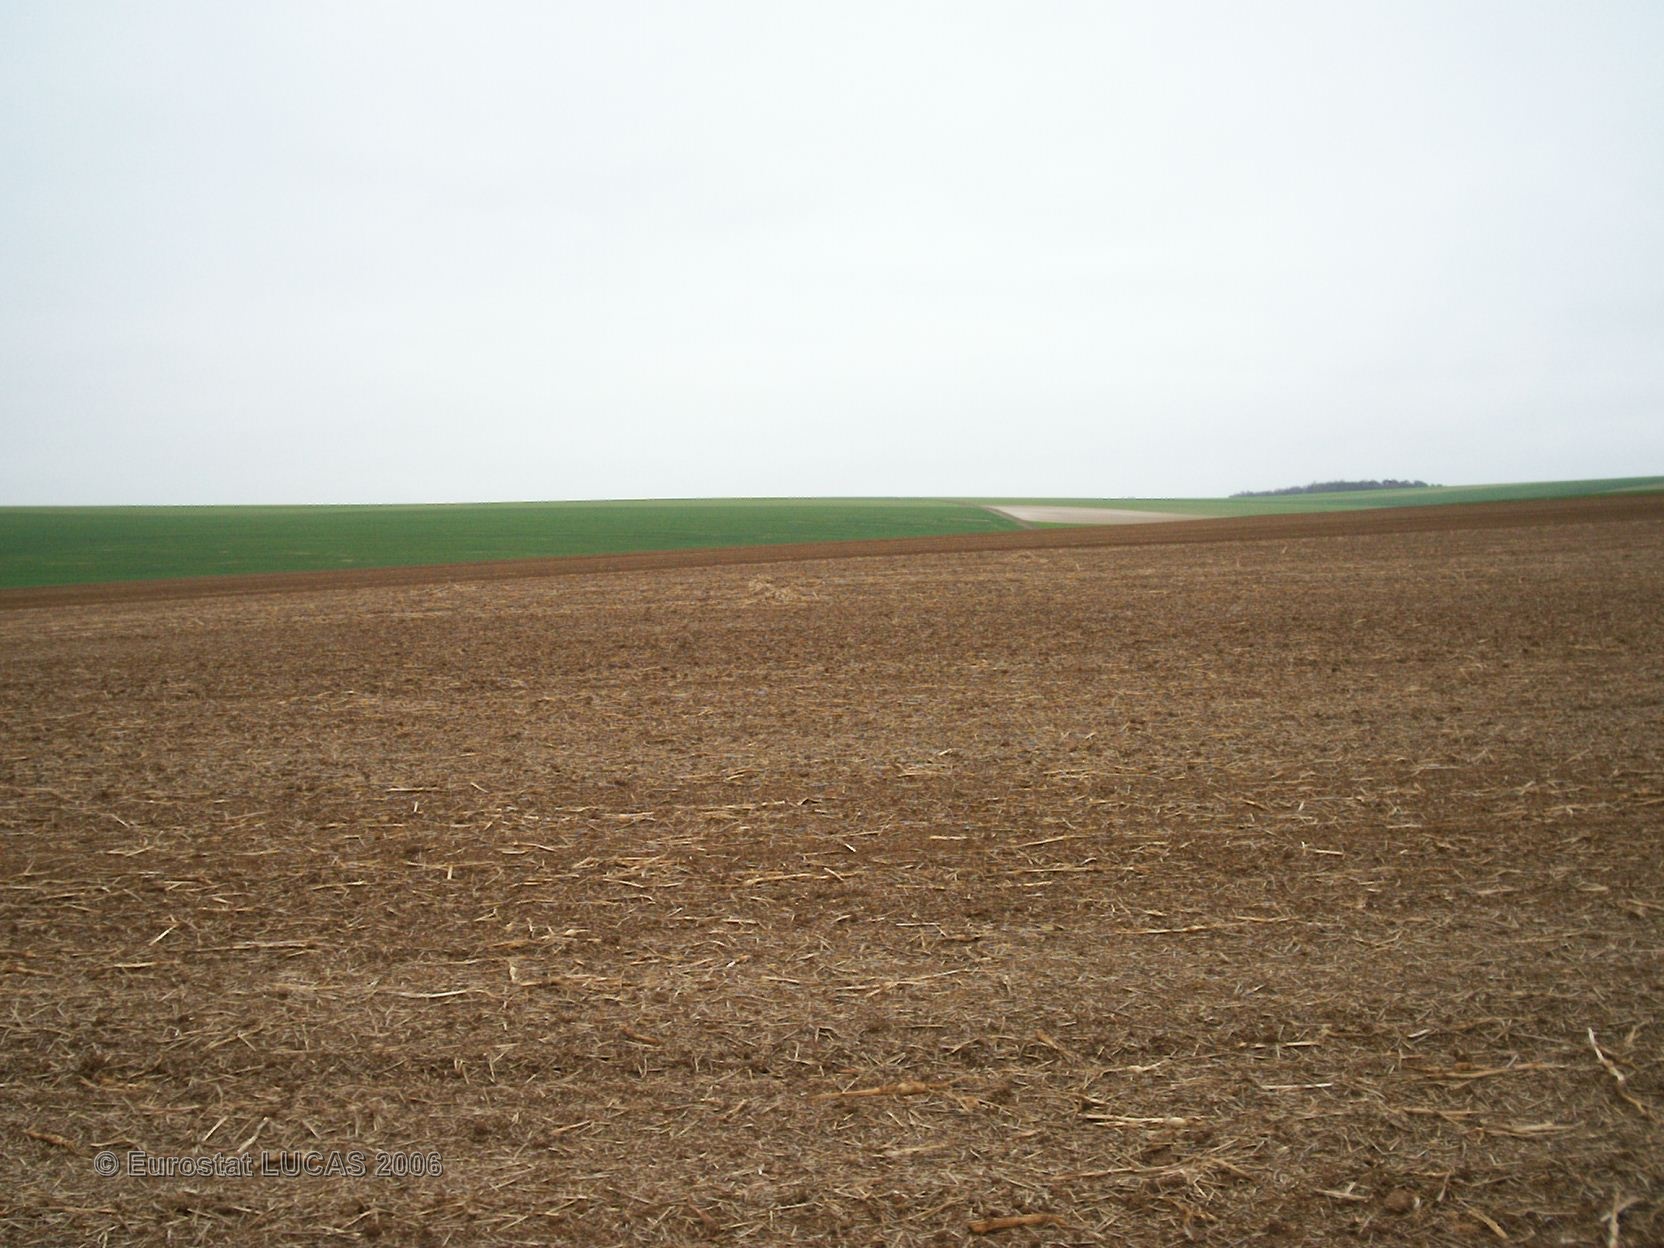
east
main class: Cropland
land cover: Sugar beet
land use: Agriculture (excluding fallow land and kitchen gardens)
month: April
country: FR
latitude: 49.2729
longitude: 4.4298
